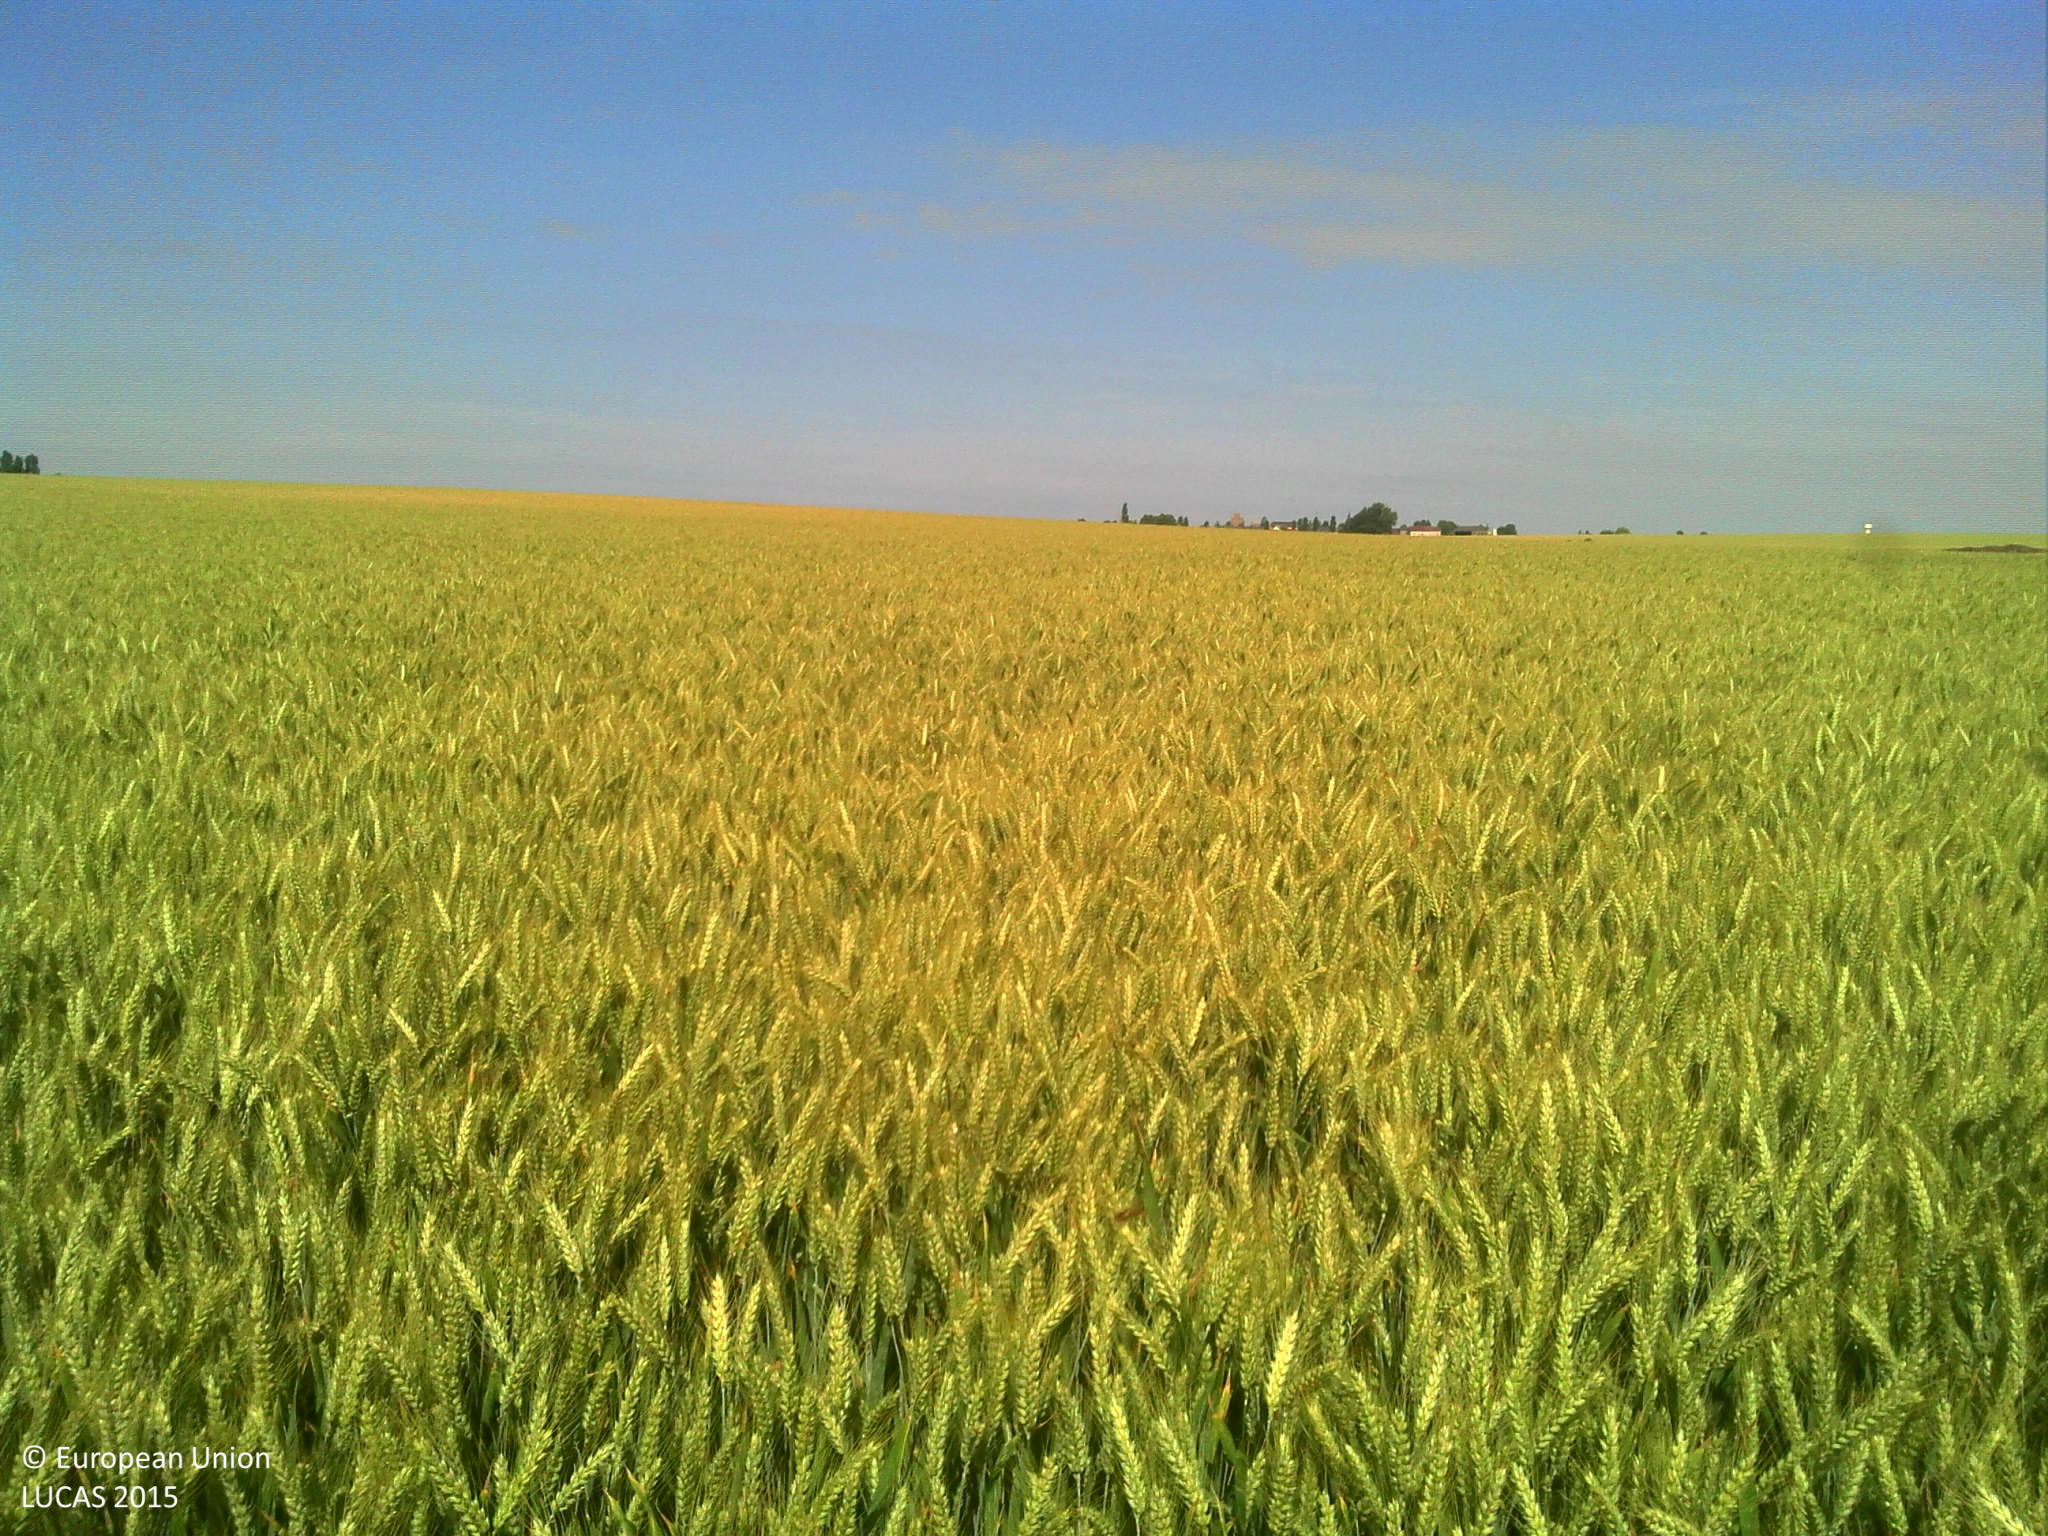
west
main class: Cropland
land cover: Common wheat
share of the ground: > 75 %
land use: Agriculture (excluding fallow land and kitchen gardens)
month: June
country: FR
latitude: 48.5391
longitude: 1.4090
